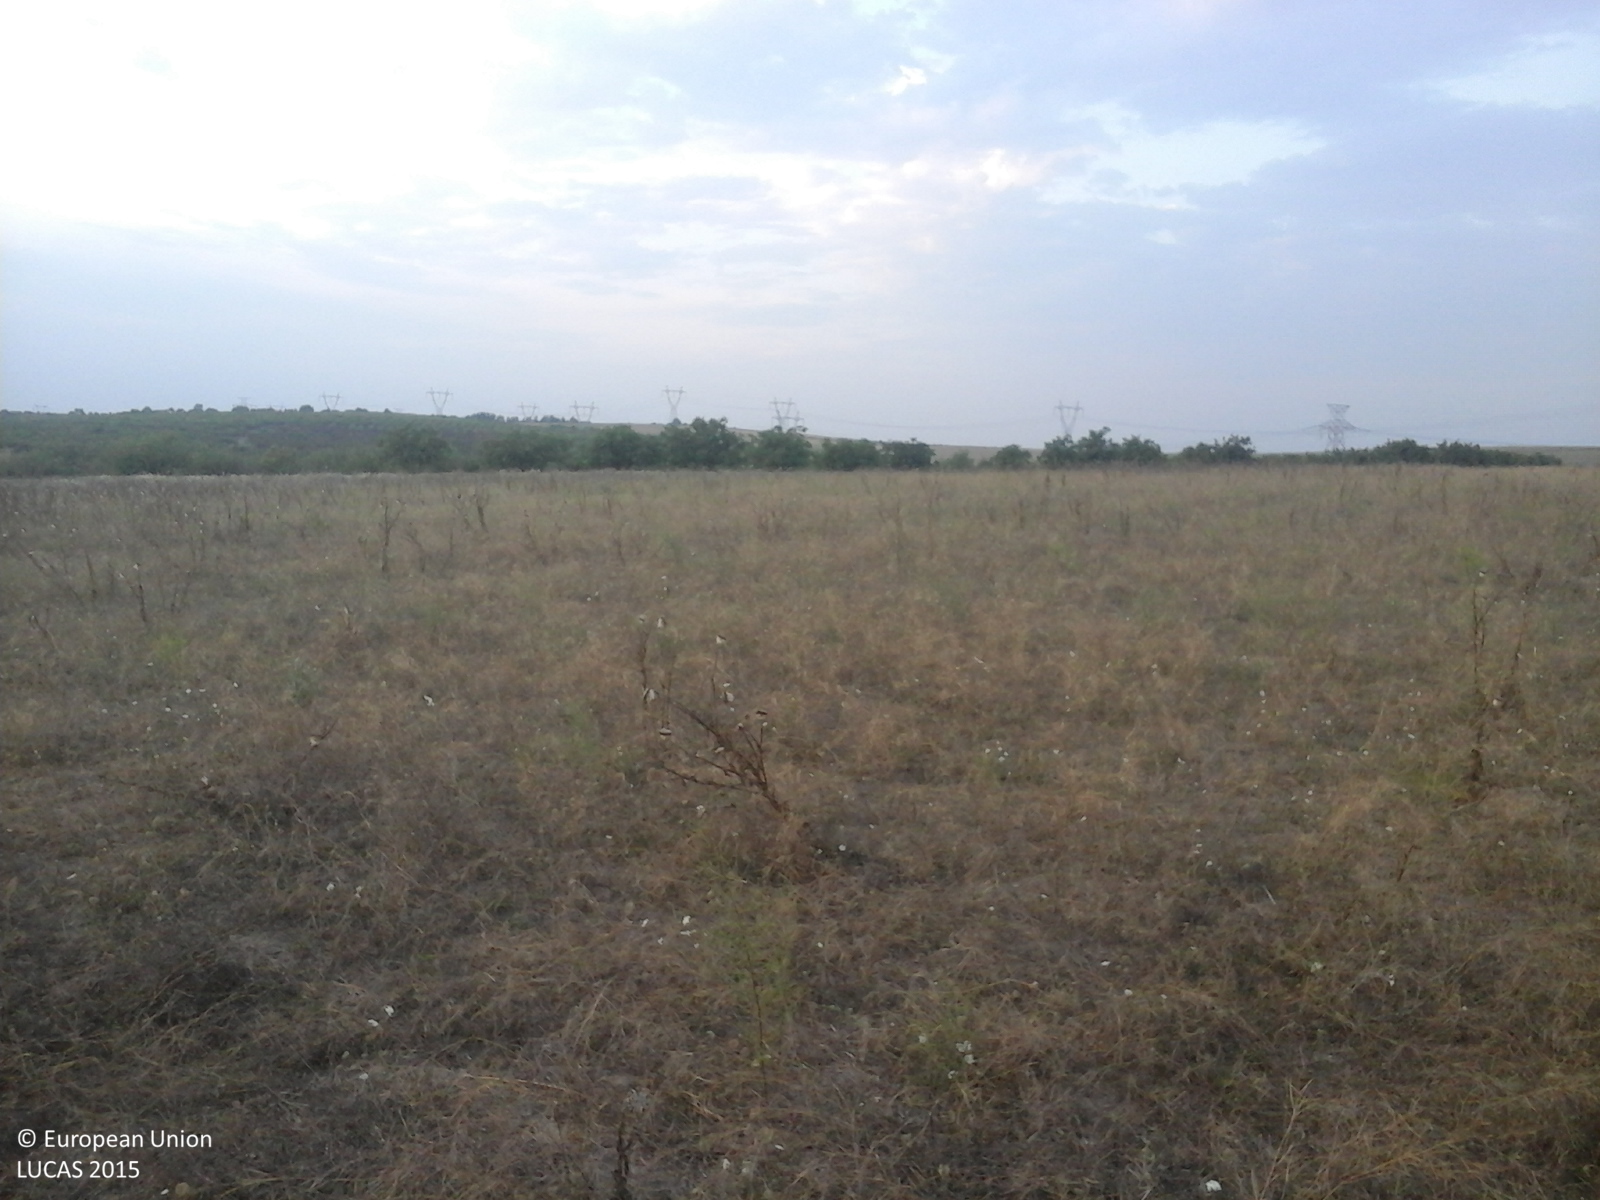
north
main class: Grassland
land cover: Spontaneously vegetated surfaces
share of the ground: > 75 %
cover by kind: herbaceous plants 100 %
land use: Agriculture (excluding fallow land and kitchen gardens)
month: August
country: RO
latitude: 44.3370
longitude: 28.0552
